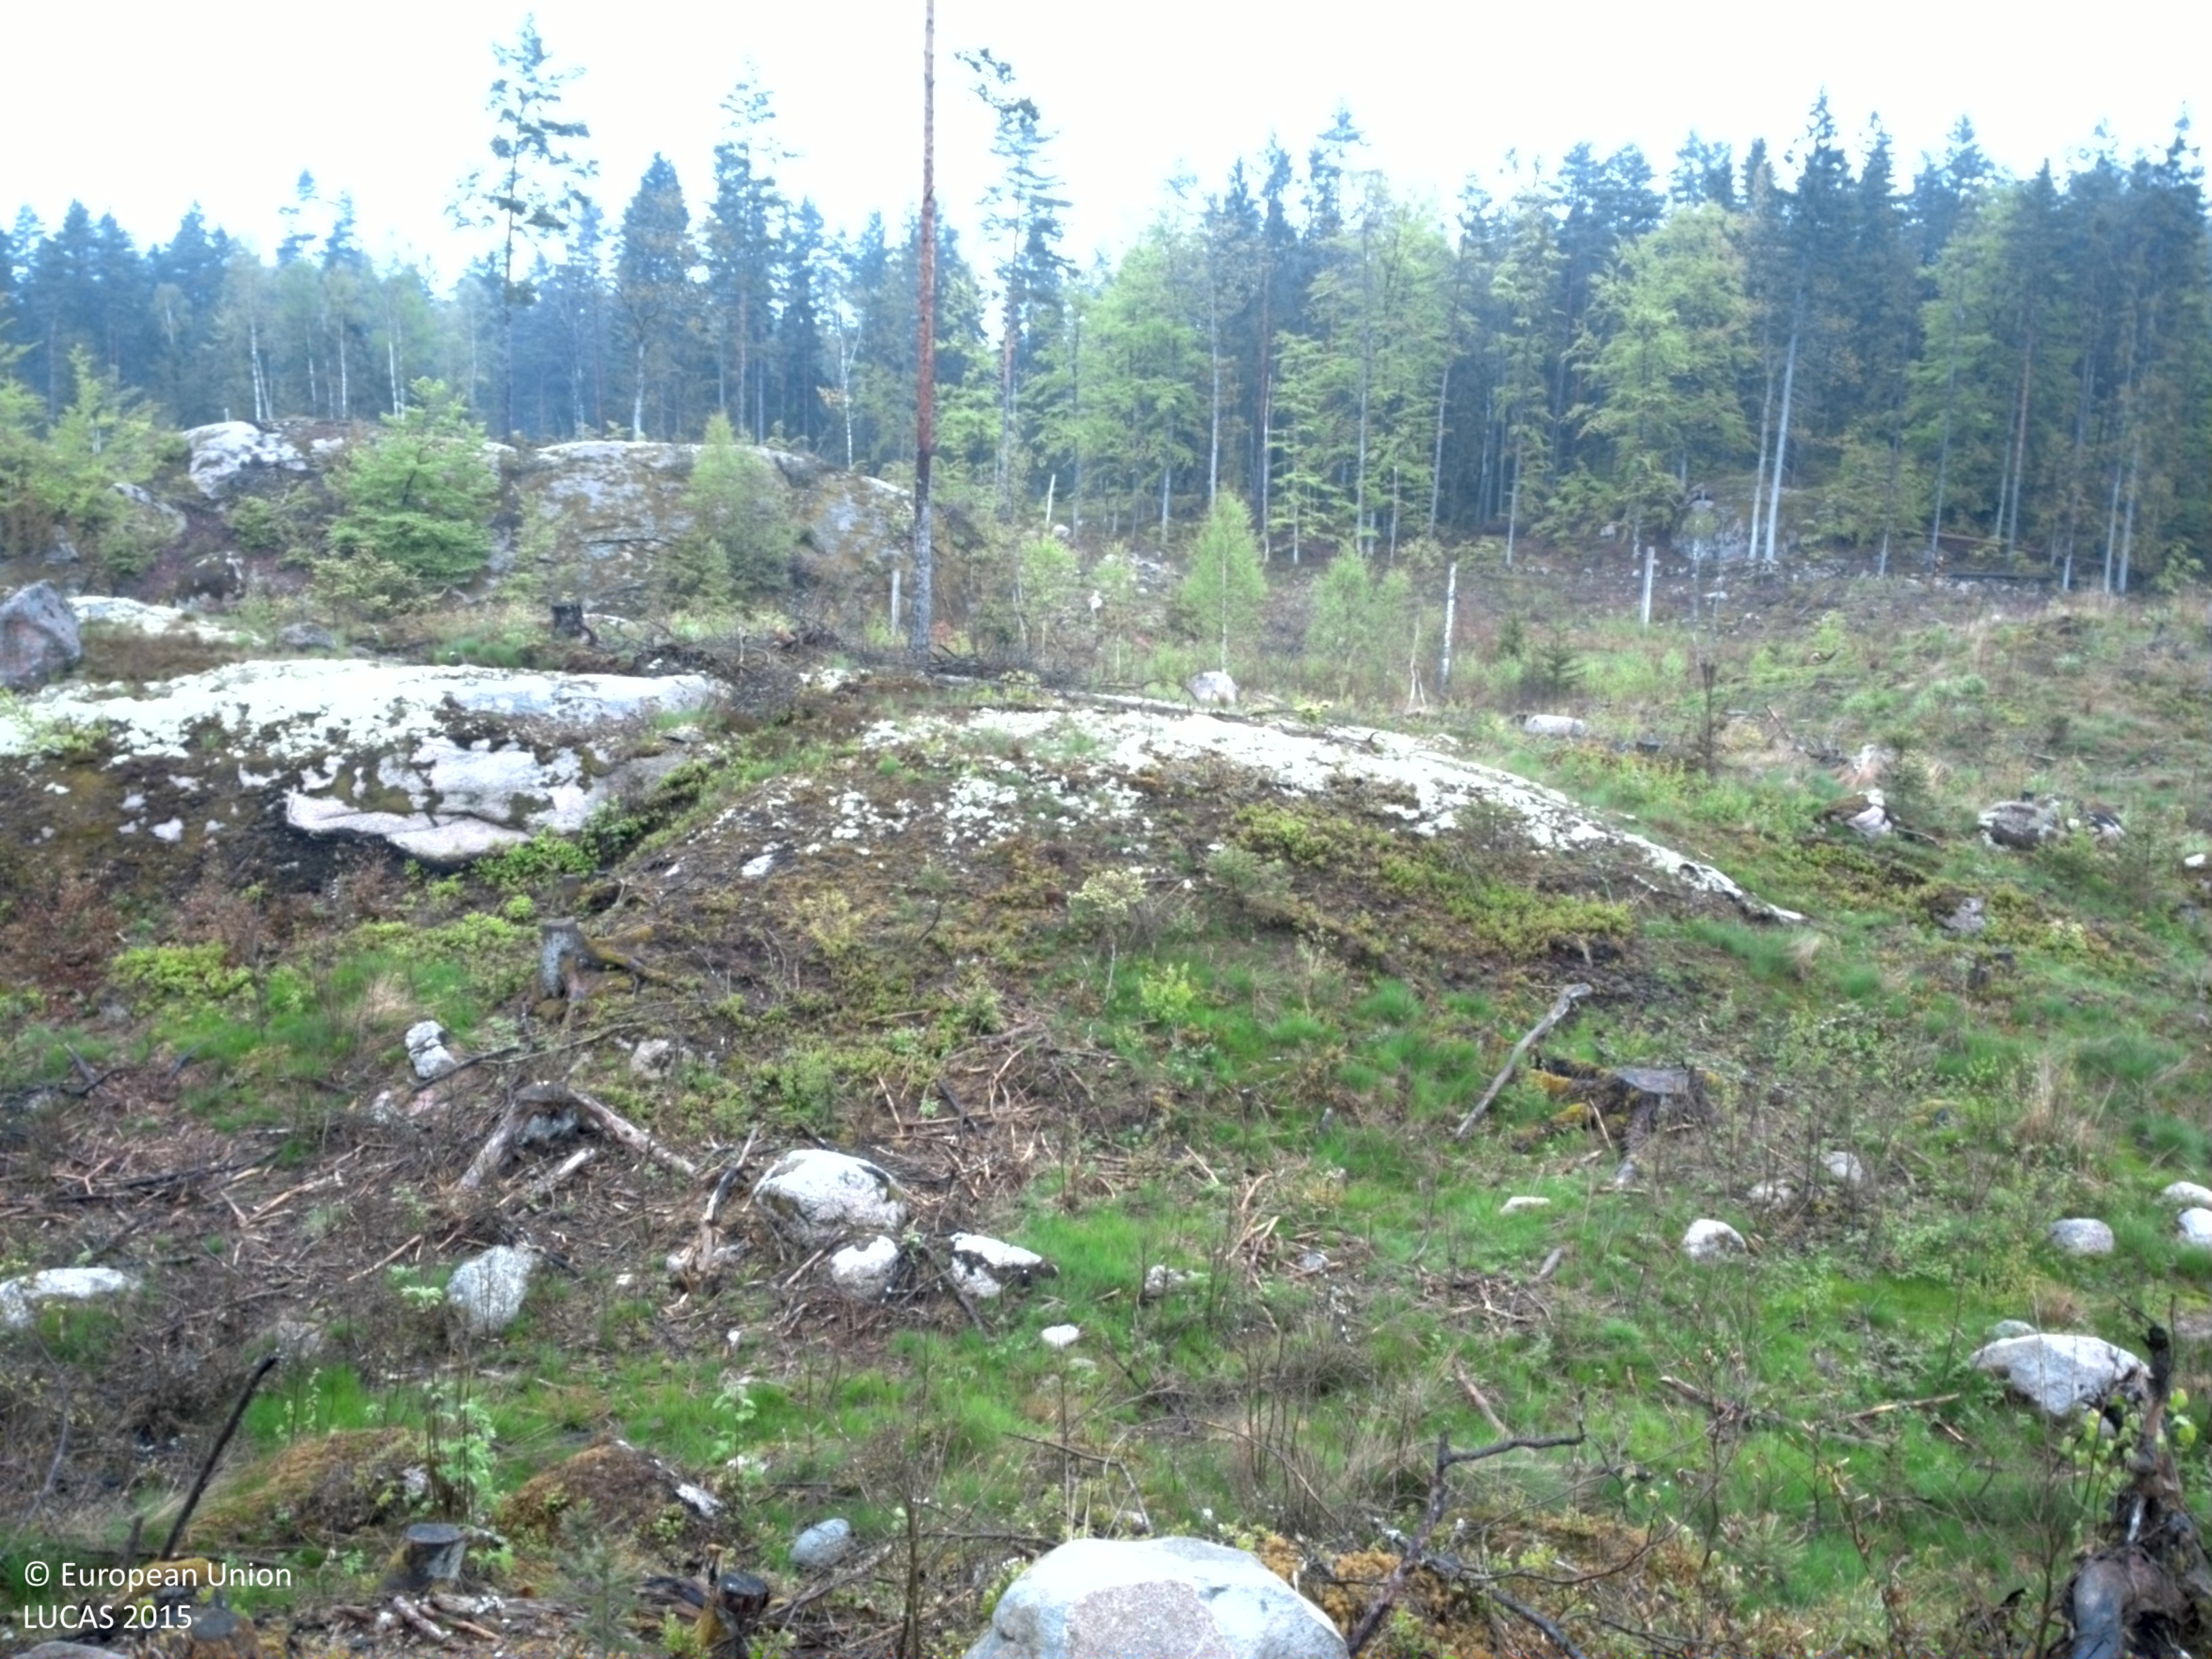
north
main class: Shrubland
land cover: Shrubland with sparse tree cover
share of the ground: 50 - 75 %
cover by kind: shrubs 65 %, herbaceous plants 25 %, coniferous forest trees 5 %, lichens and mosses 5 %
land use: Forestry
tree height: < 5 m
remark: Clear cut
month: May
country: SE
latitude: 56.3616
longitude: 15.4216
